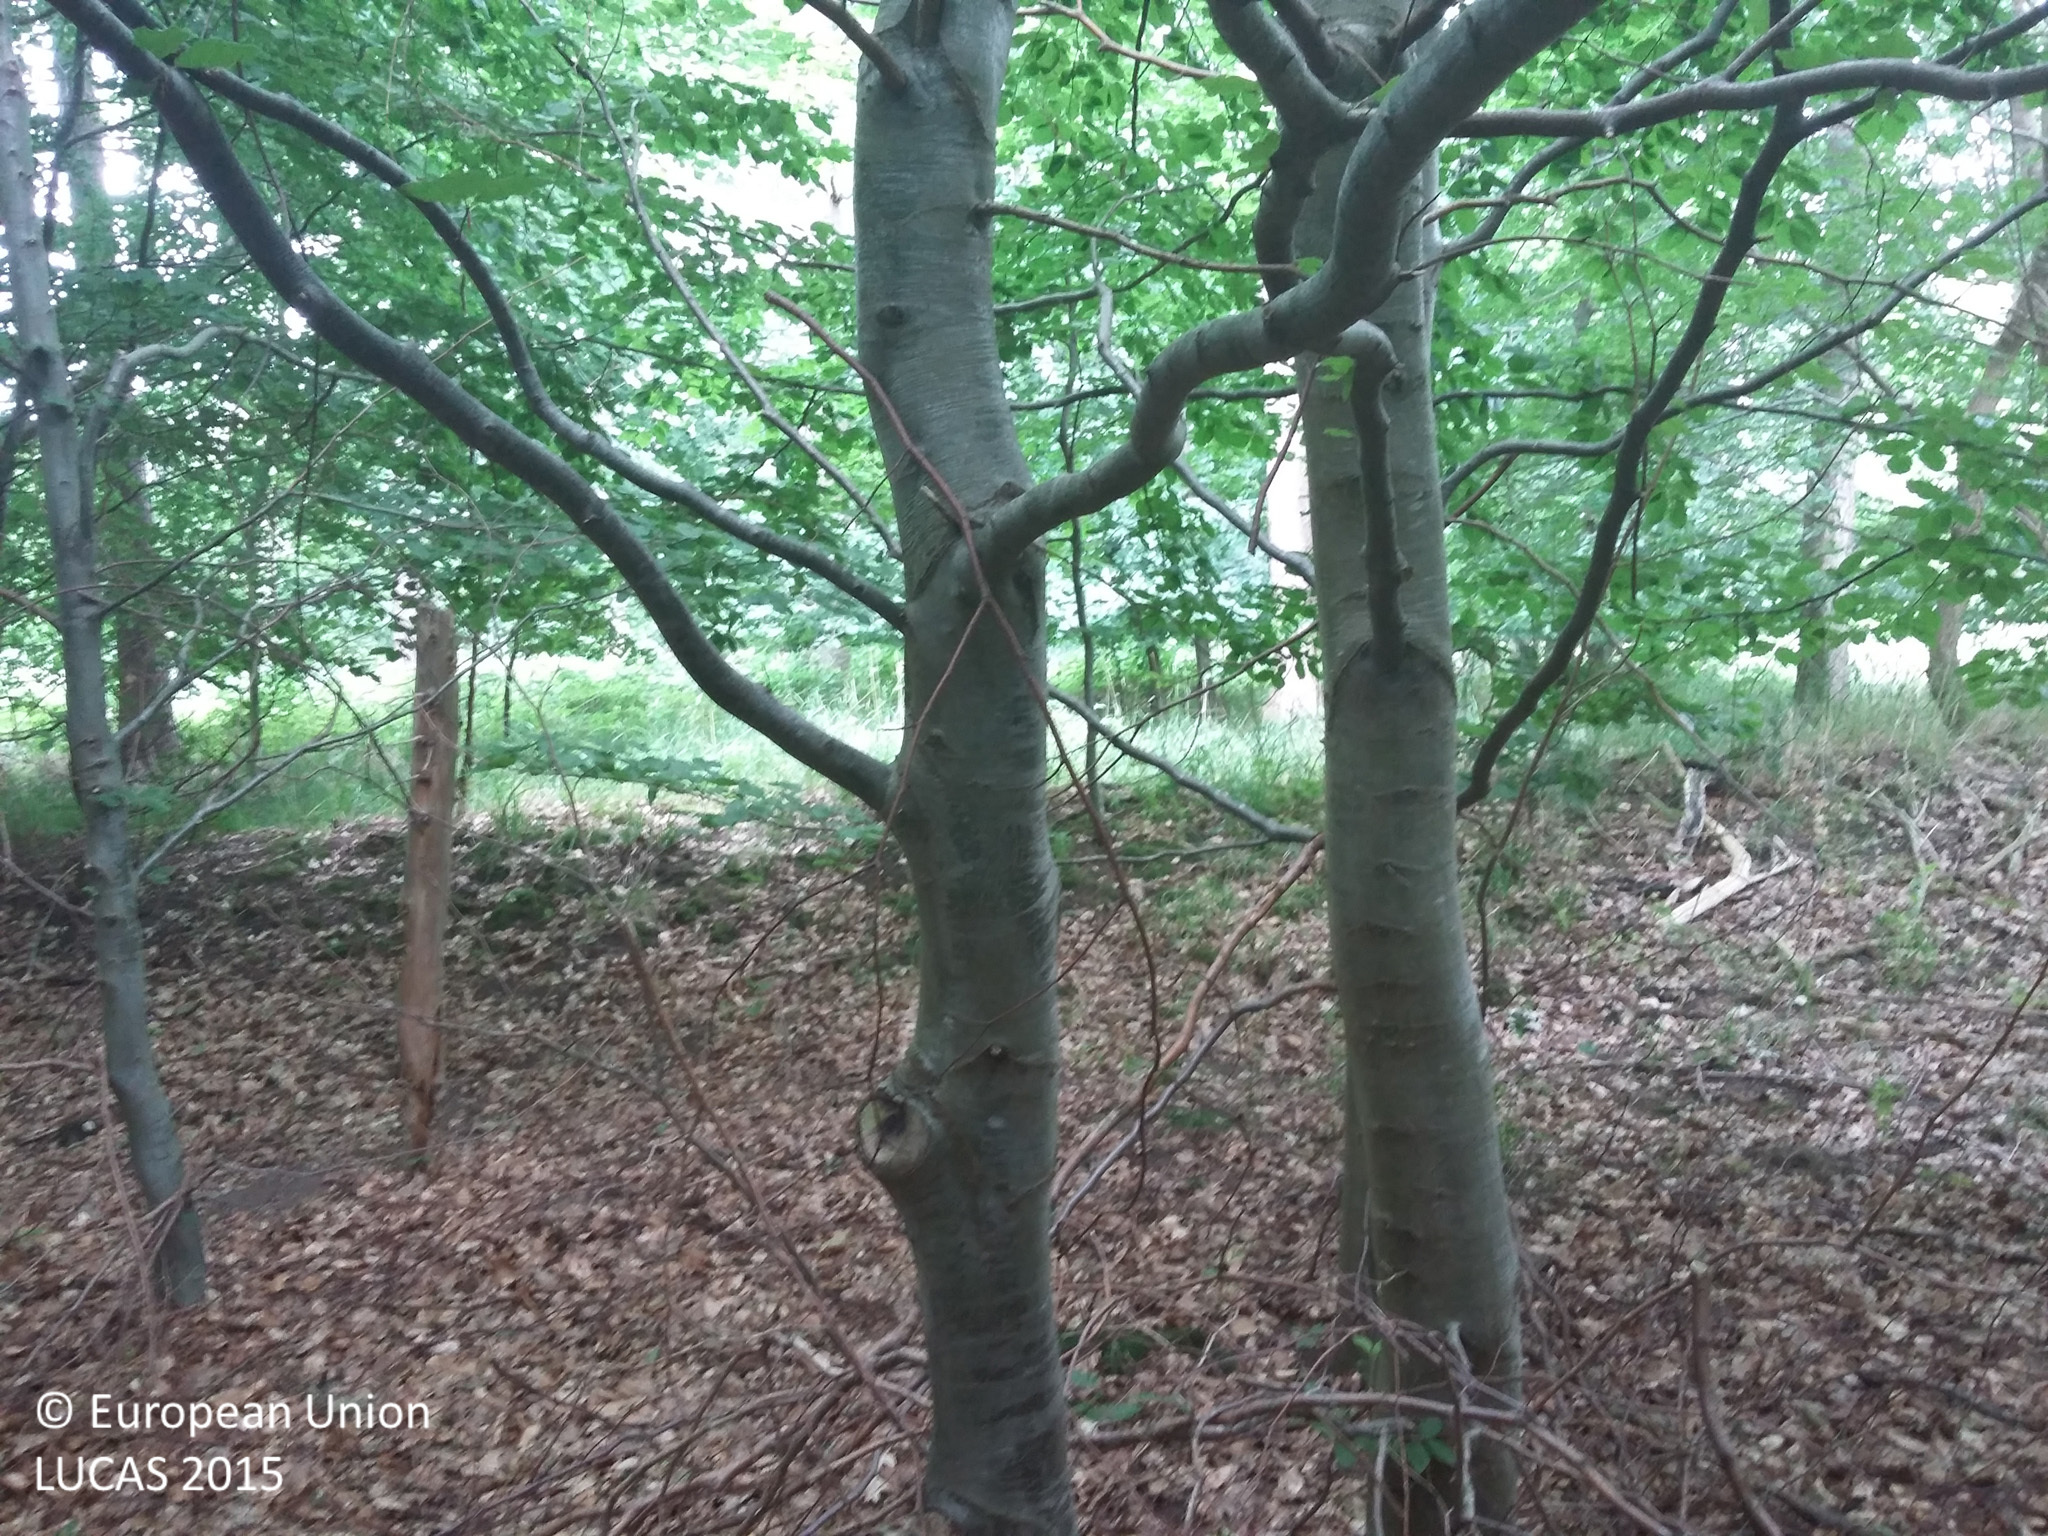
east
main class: Woodland
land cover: Broadleaved woodland
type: beech forest
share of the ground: > 75 %
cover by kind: broadleaved forest trees 95 %, unconsolidated bare surface 5 %
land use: Forestry
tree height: > 5 m
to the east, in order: Broadleaved woodland; Spruce dominated coniferous woodland; Tracks; Spruce dominated coniferous woodland; Ditches and canals; Broadleaved woodland; Grassland without tree/shrub cover; Broadleaved woodland; Tracks
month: July
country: DK
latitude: 55.7398
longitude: 12.0528
